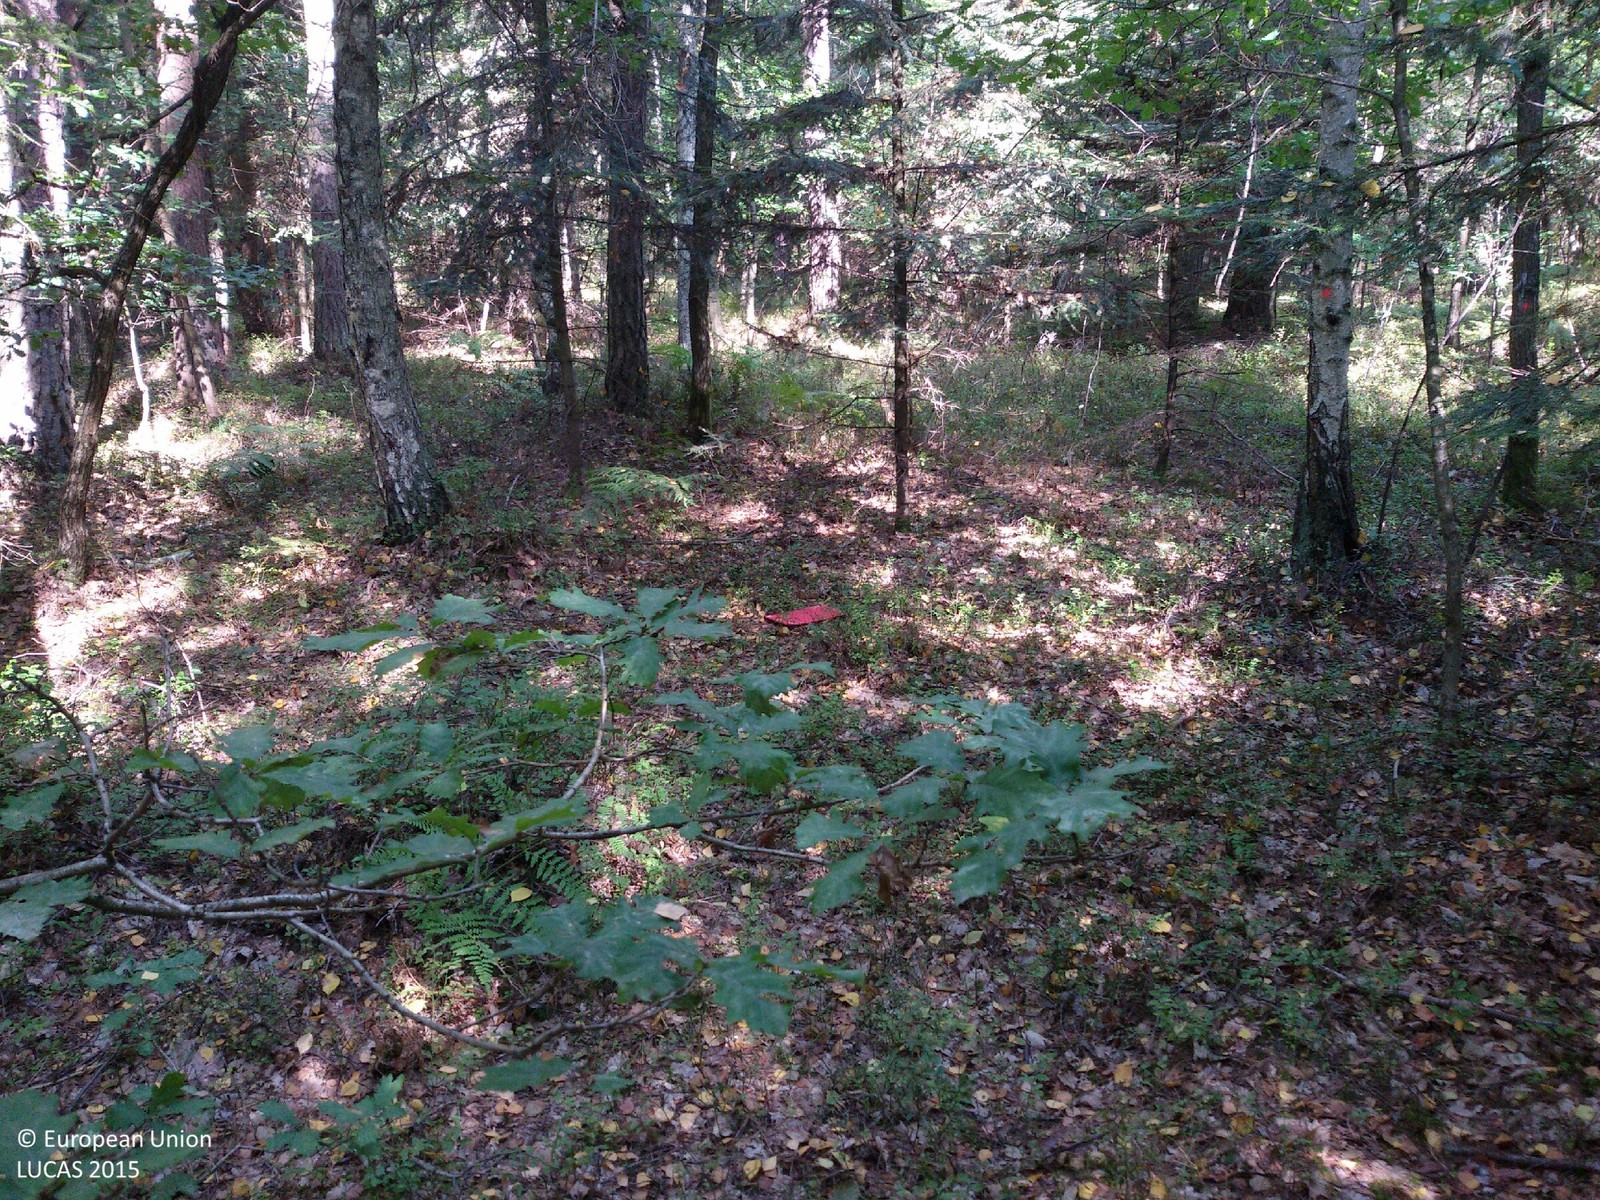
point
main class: Woodland
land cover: Pine dominated mixed woodland
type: hemiboreal forest and nemoral coniferous forest and mixed broadleaved-coniferous forest
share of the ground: > 75 %
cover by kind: coniferous forest trees 60 %, broadleaved forest trees 25 %, herbaceous plants 10 %, shrubs 5 %
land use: Forestry
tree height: > 5 m
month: August
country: PL
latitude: 50.7502
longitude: 20.8856
